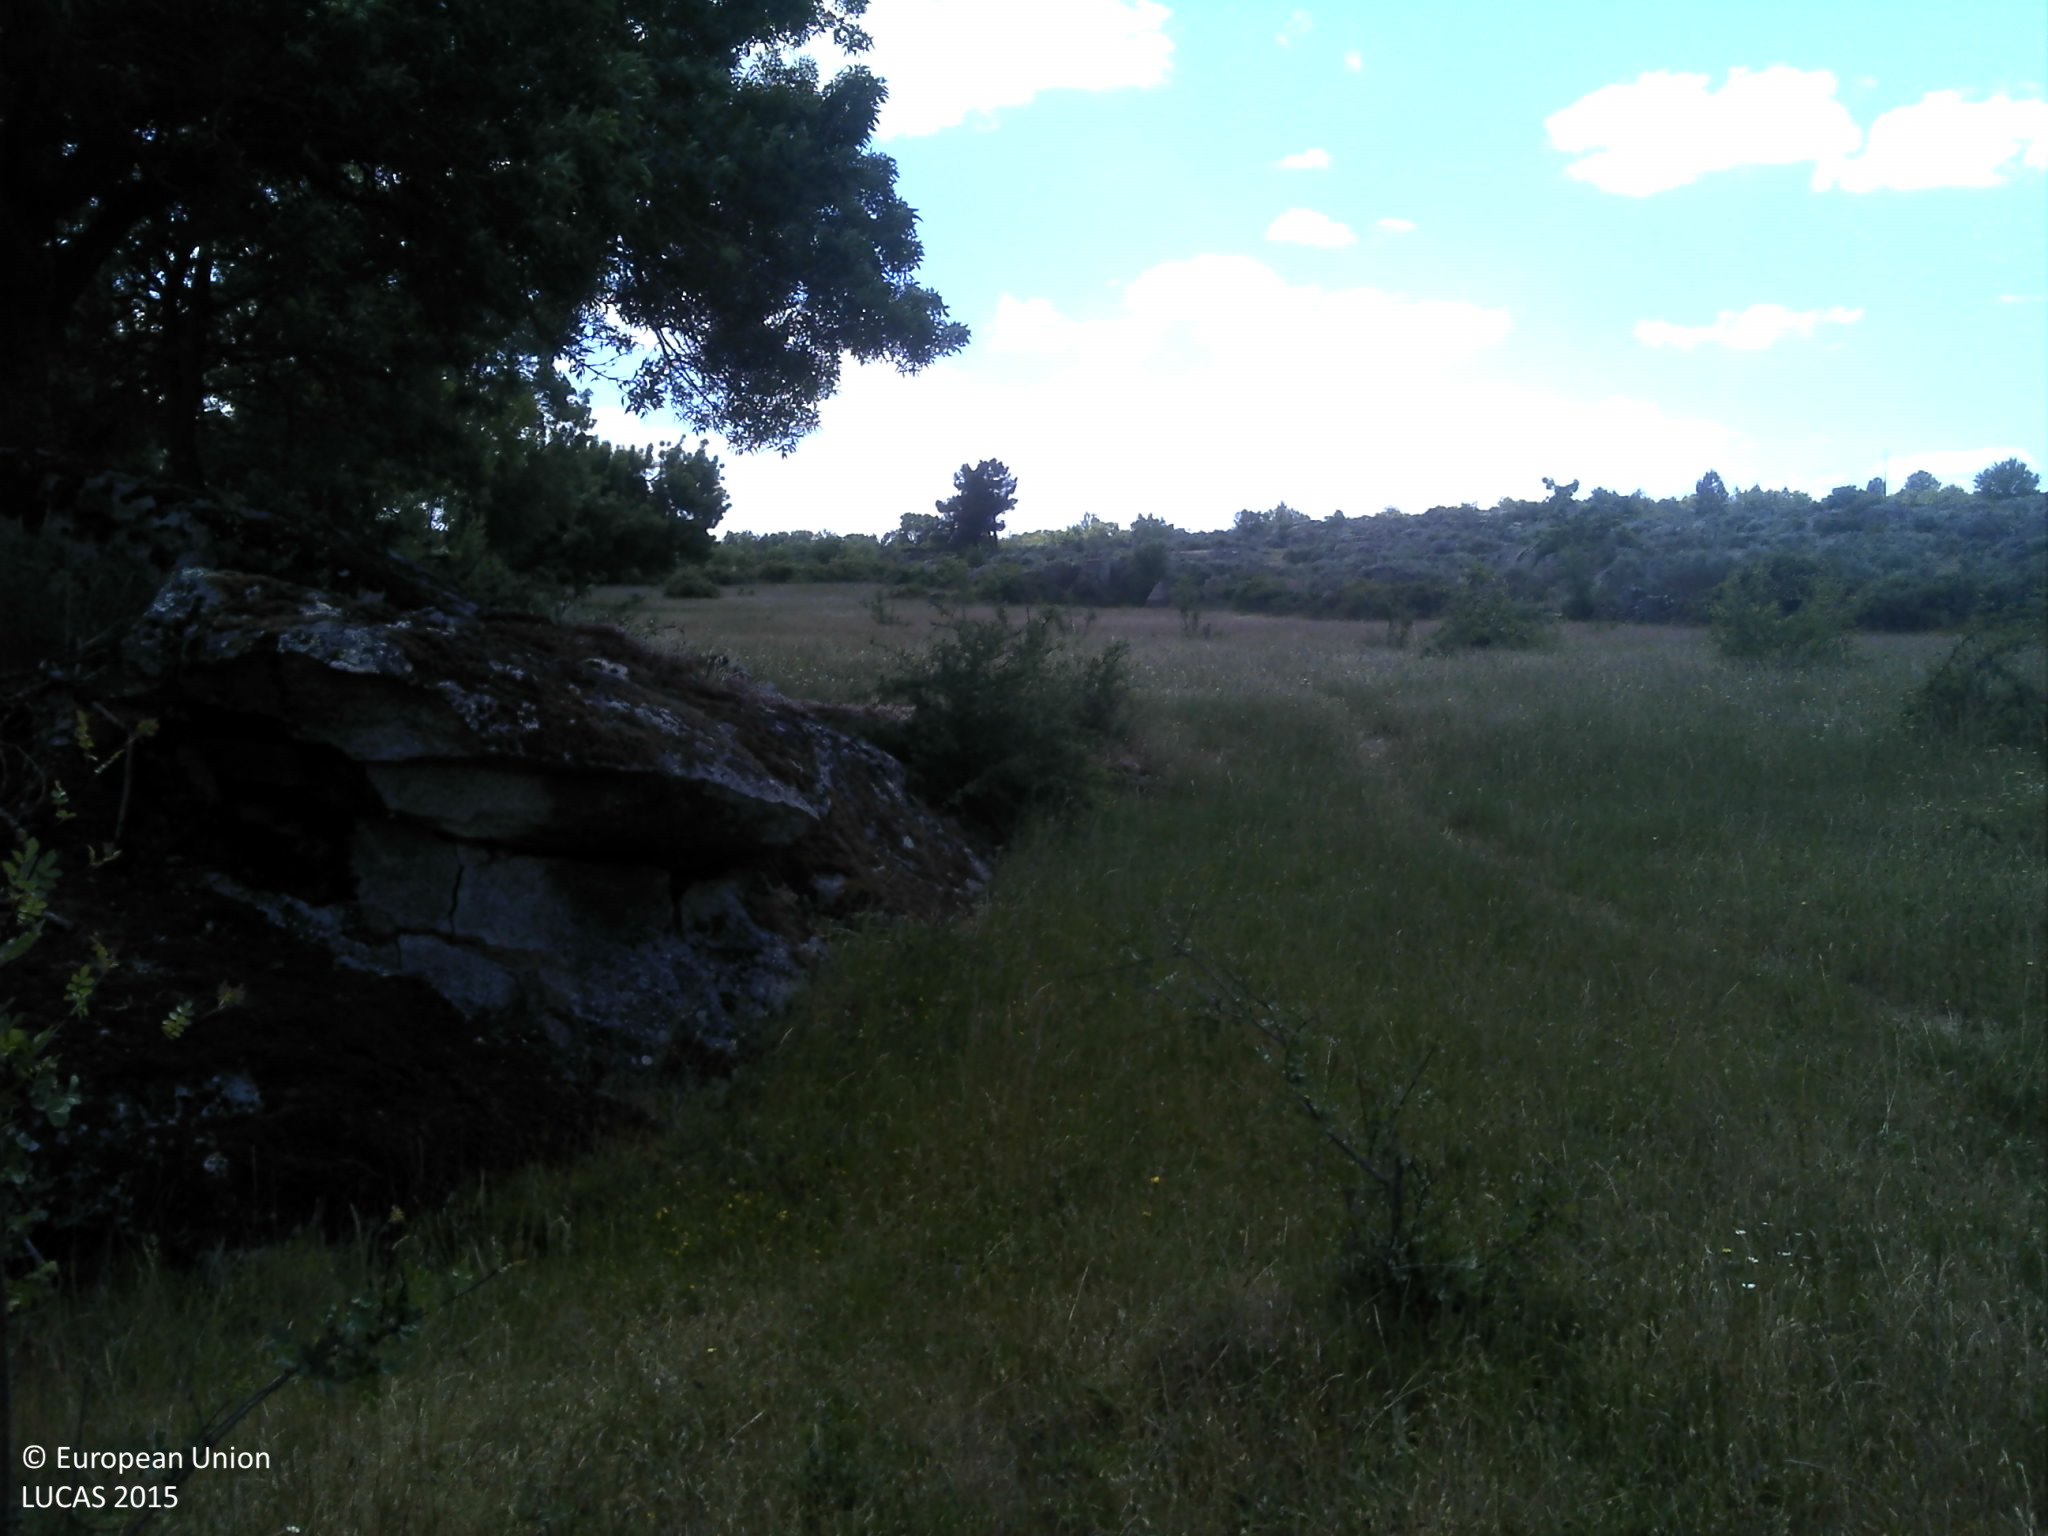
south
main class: Grassland
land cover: Grassland with sparse tree/shrub cover
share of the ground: 50 - 75 %
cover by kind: herbaceous plants 70 %, consolidated bare surface 10 %, broadleaved forest trees 5 %, shrubs 5 %
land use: Agriculture (excluding fallow land and kitchen gardens)
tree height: > 5 m
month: May
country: PT
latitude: 40.7016
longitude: -7.1363
